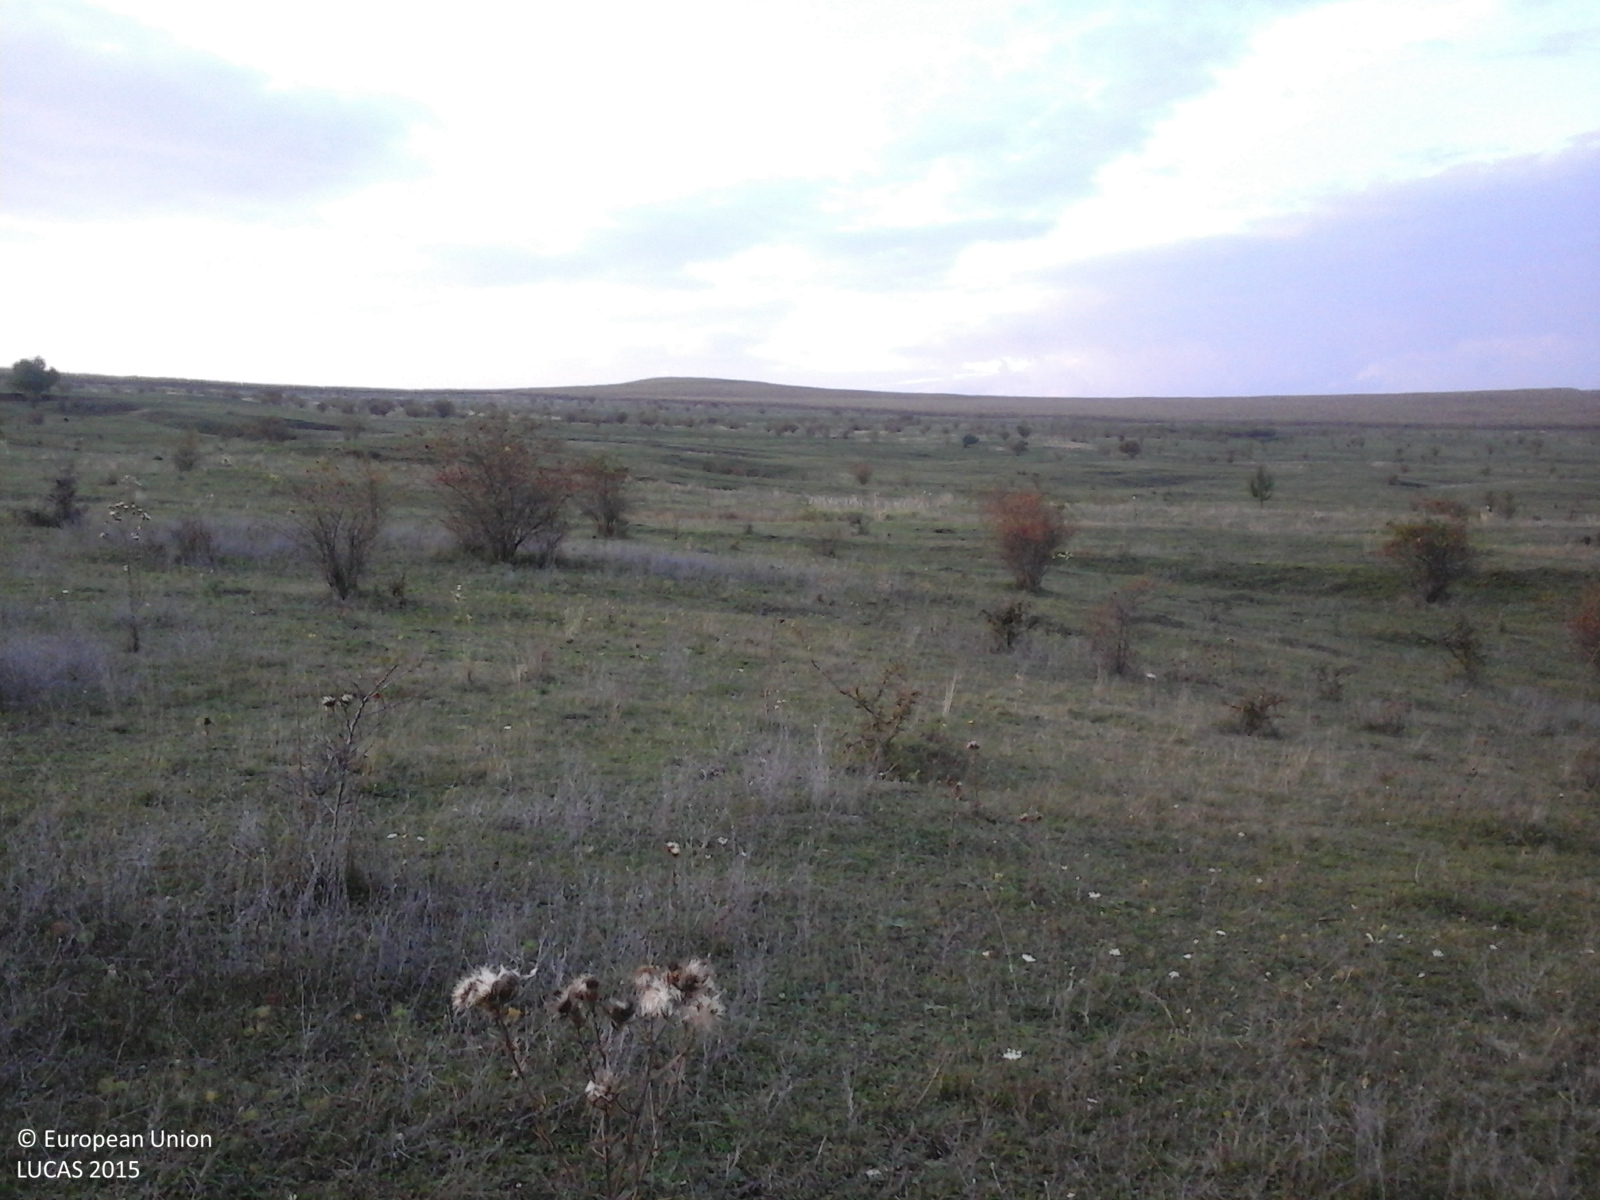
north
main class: Grassland
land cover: Grassland with sparse tree/shrub cover
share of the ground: > 75 %
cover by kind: herbaceous plants 95 %, broadleaved forest trees 5 %
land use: Agriculture (excluding fallow land and kitchen gardens)
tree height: < 5 m
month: October
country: RO
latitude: 46.4951
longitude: 24.0582
